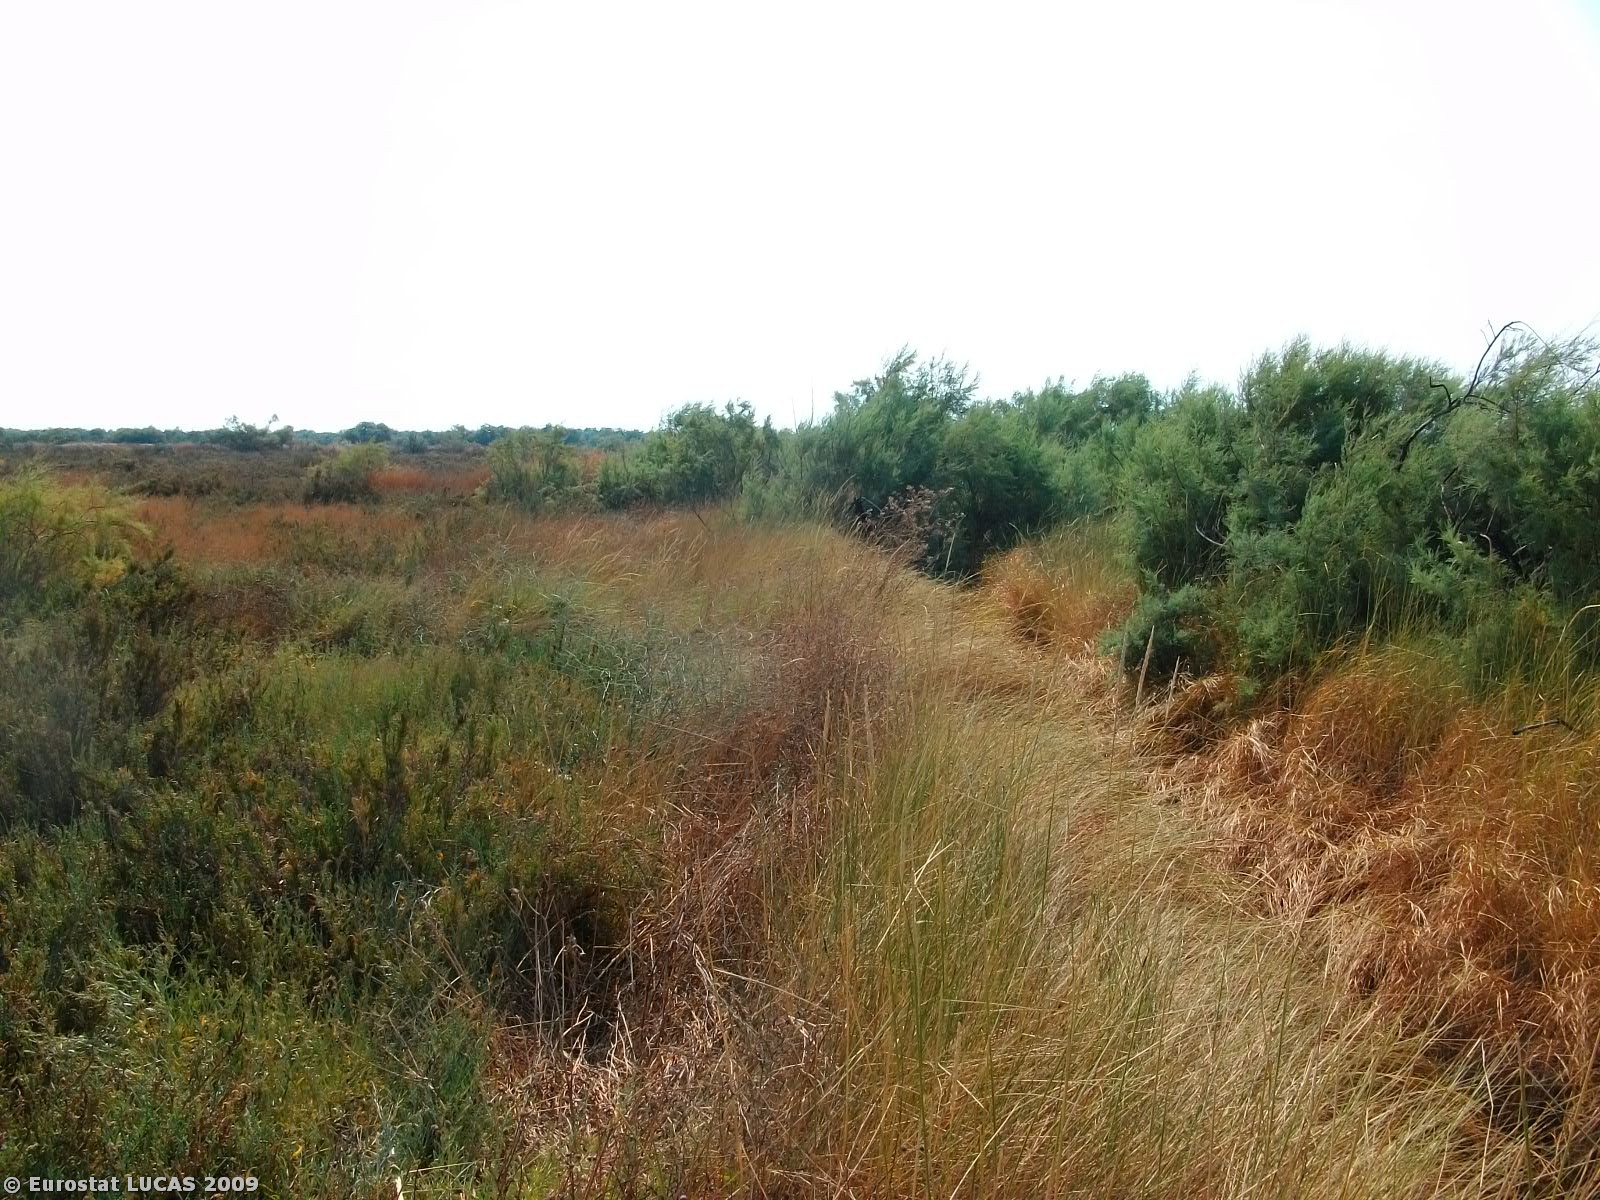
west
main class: Grassland
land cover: Spontaneously vegetated surfaces
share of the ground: > 75 %
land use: Nature reserves
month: August
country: GR
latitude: 36.8159
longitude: 22.7223
